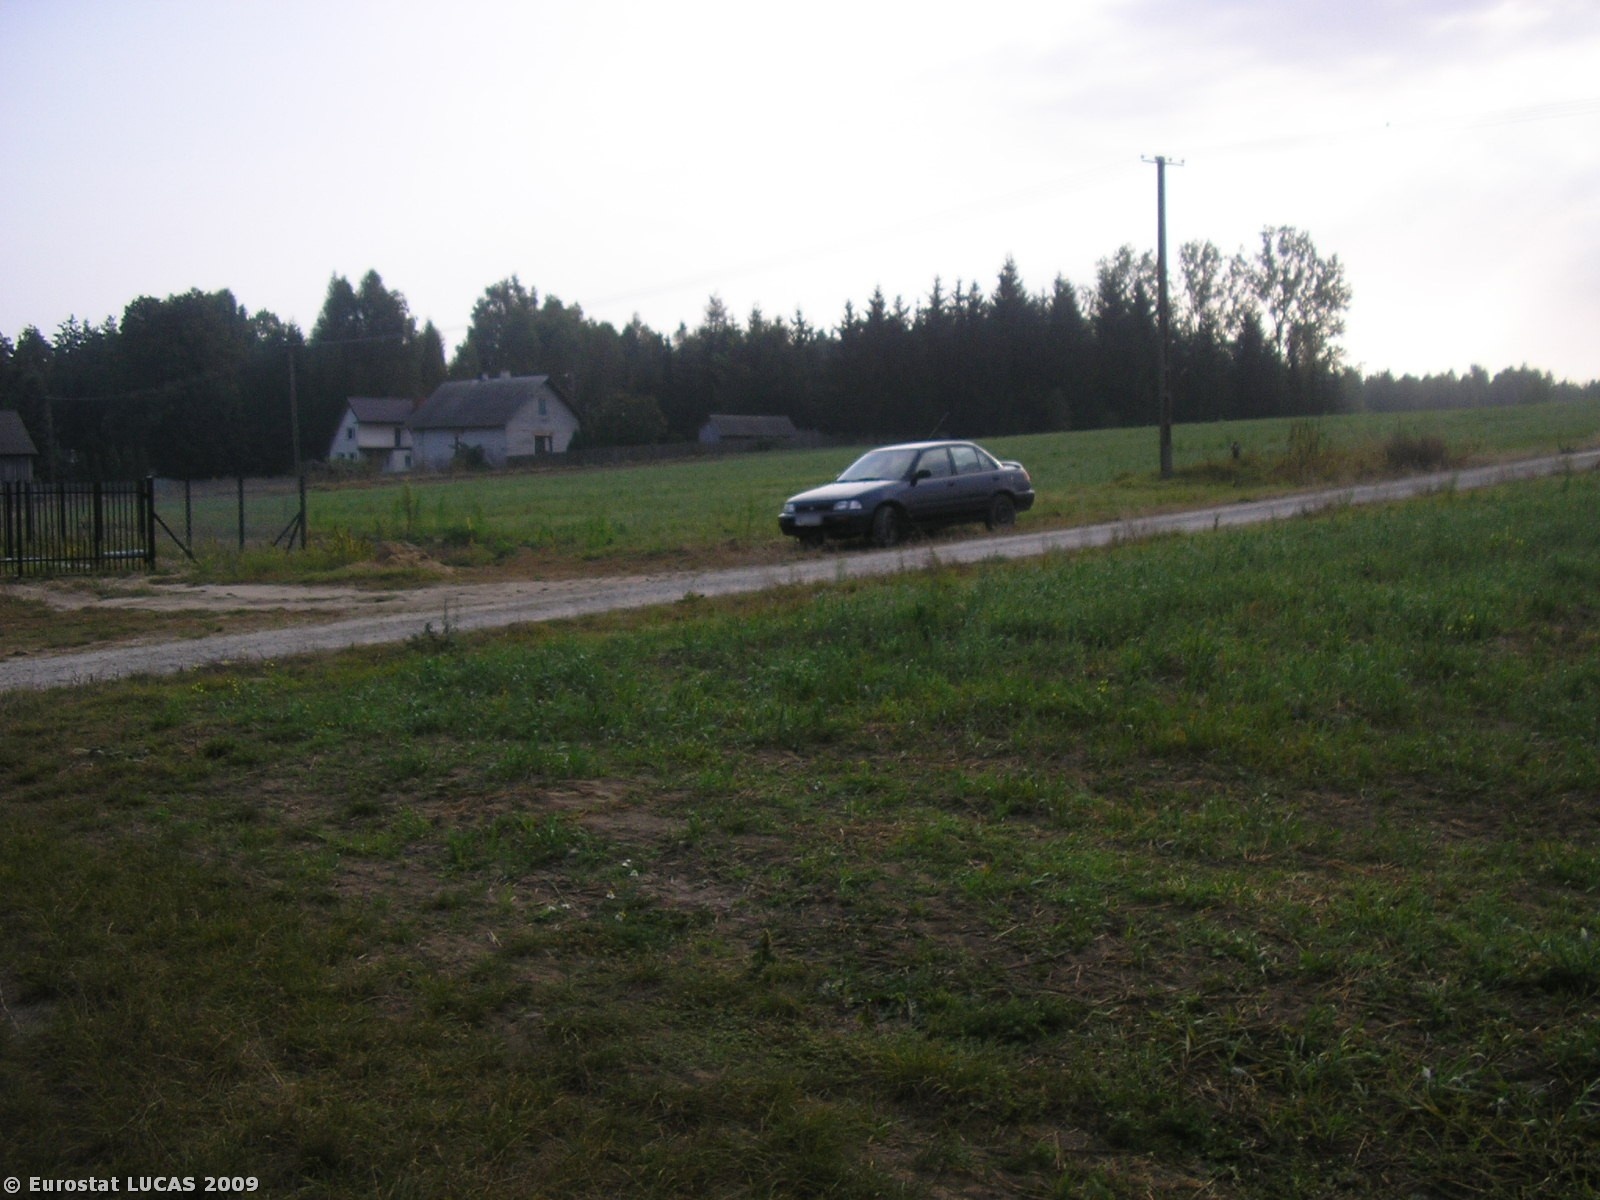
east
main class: Grassland
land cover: Grassland without tree/shrub cover
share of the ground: > 75 %
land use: Agriculture (excluding fallow land and kitchen gardens)
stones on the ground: < 10 %
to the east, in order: Grassland without tree/shrub cover; Oats; Grass margins; Tracks; Grass margins; Oats; Electric lines; Oats; Grass margins; Coniferous woodland; Tracks; Grass margins; Ditches and canals; Grass margins; Paved roads, cycling and walking lanes; Grass margins; Oats; Coniferous woodland
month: September
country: PL
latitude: 51.9694
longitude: 20.6513
